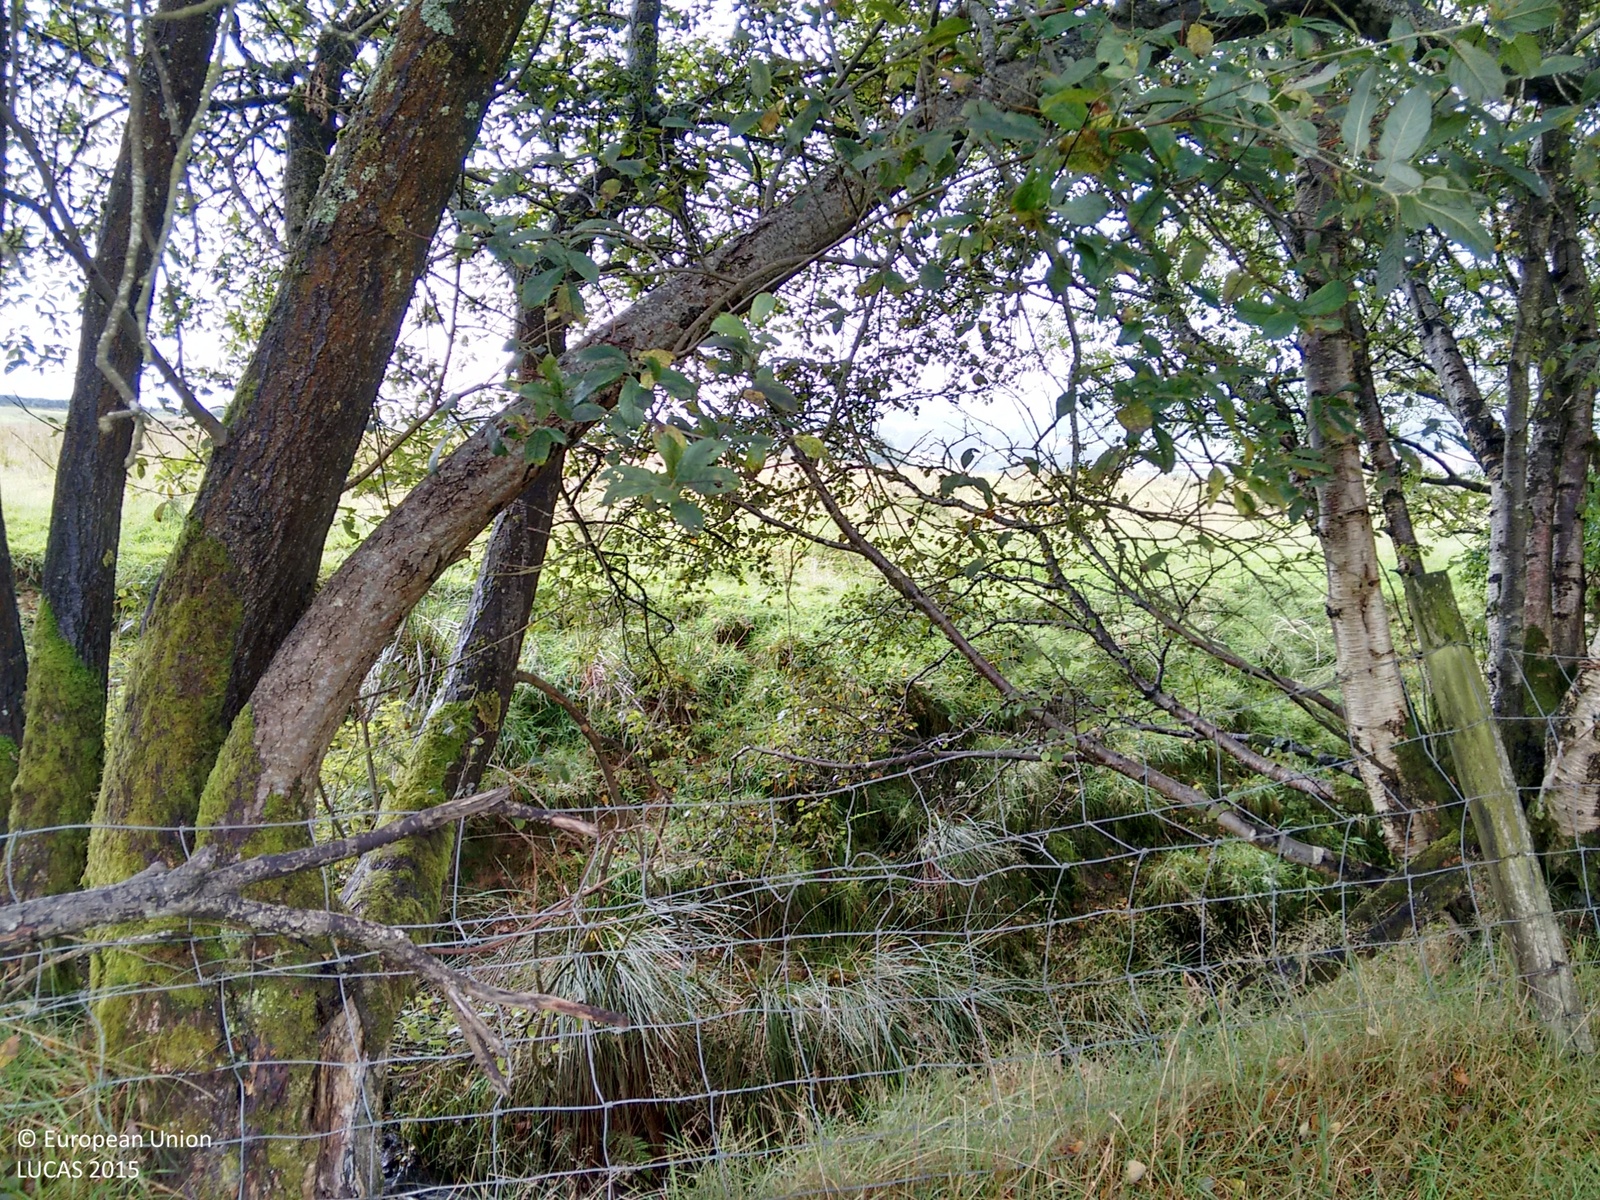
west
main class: Grassland
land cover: Grassland without tree/shrub cover
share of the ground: > 75 %
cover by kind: herbaceous plants 100 %
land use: Agriculture (excluding fallow land and kitchen gardens)
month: September
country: GB
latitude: 52.1879
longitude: -3.9455
